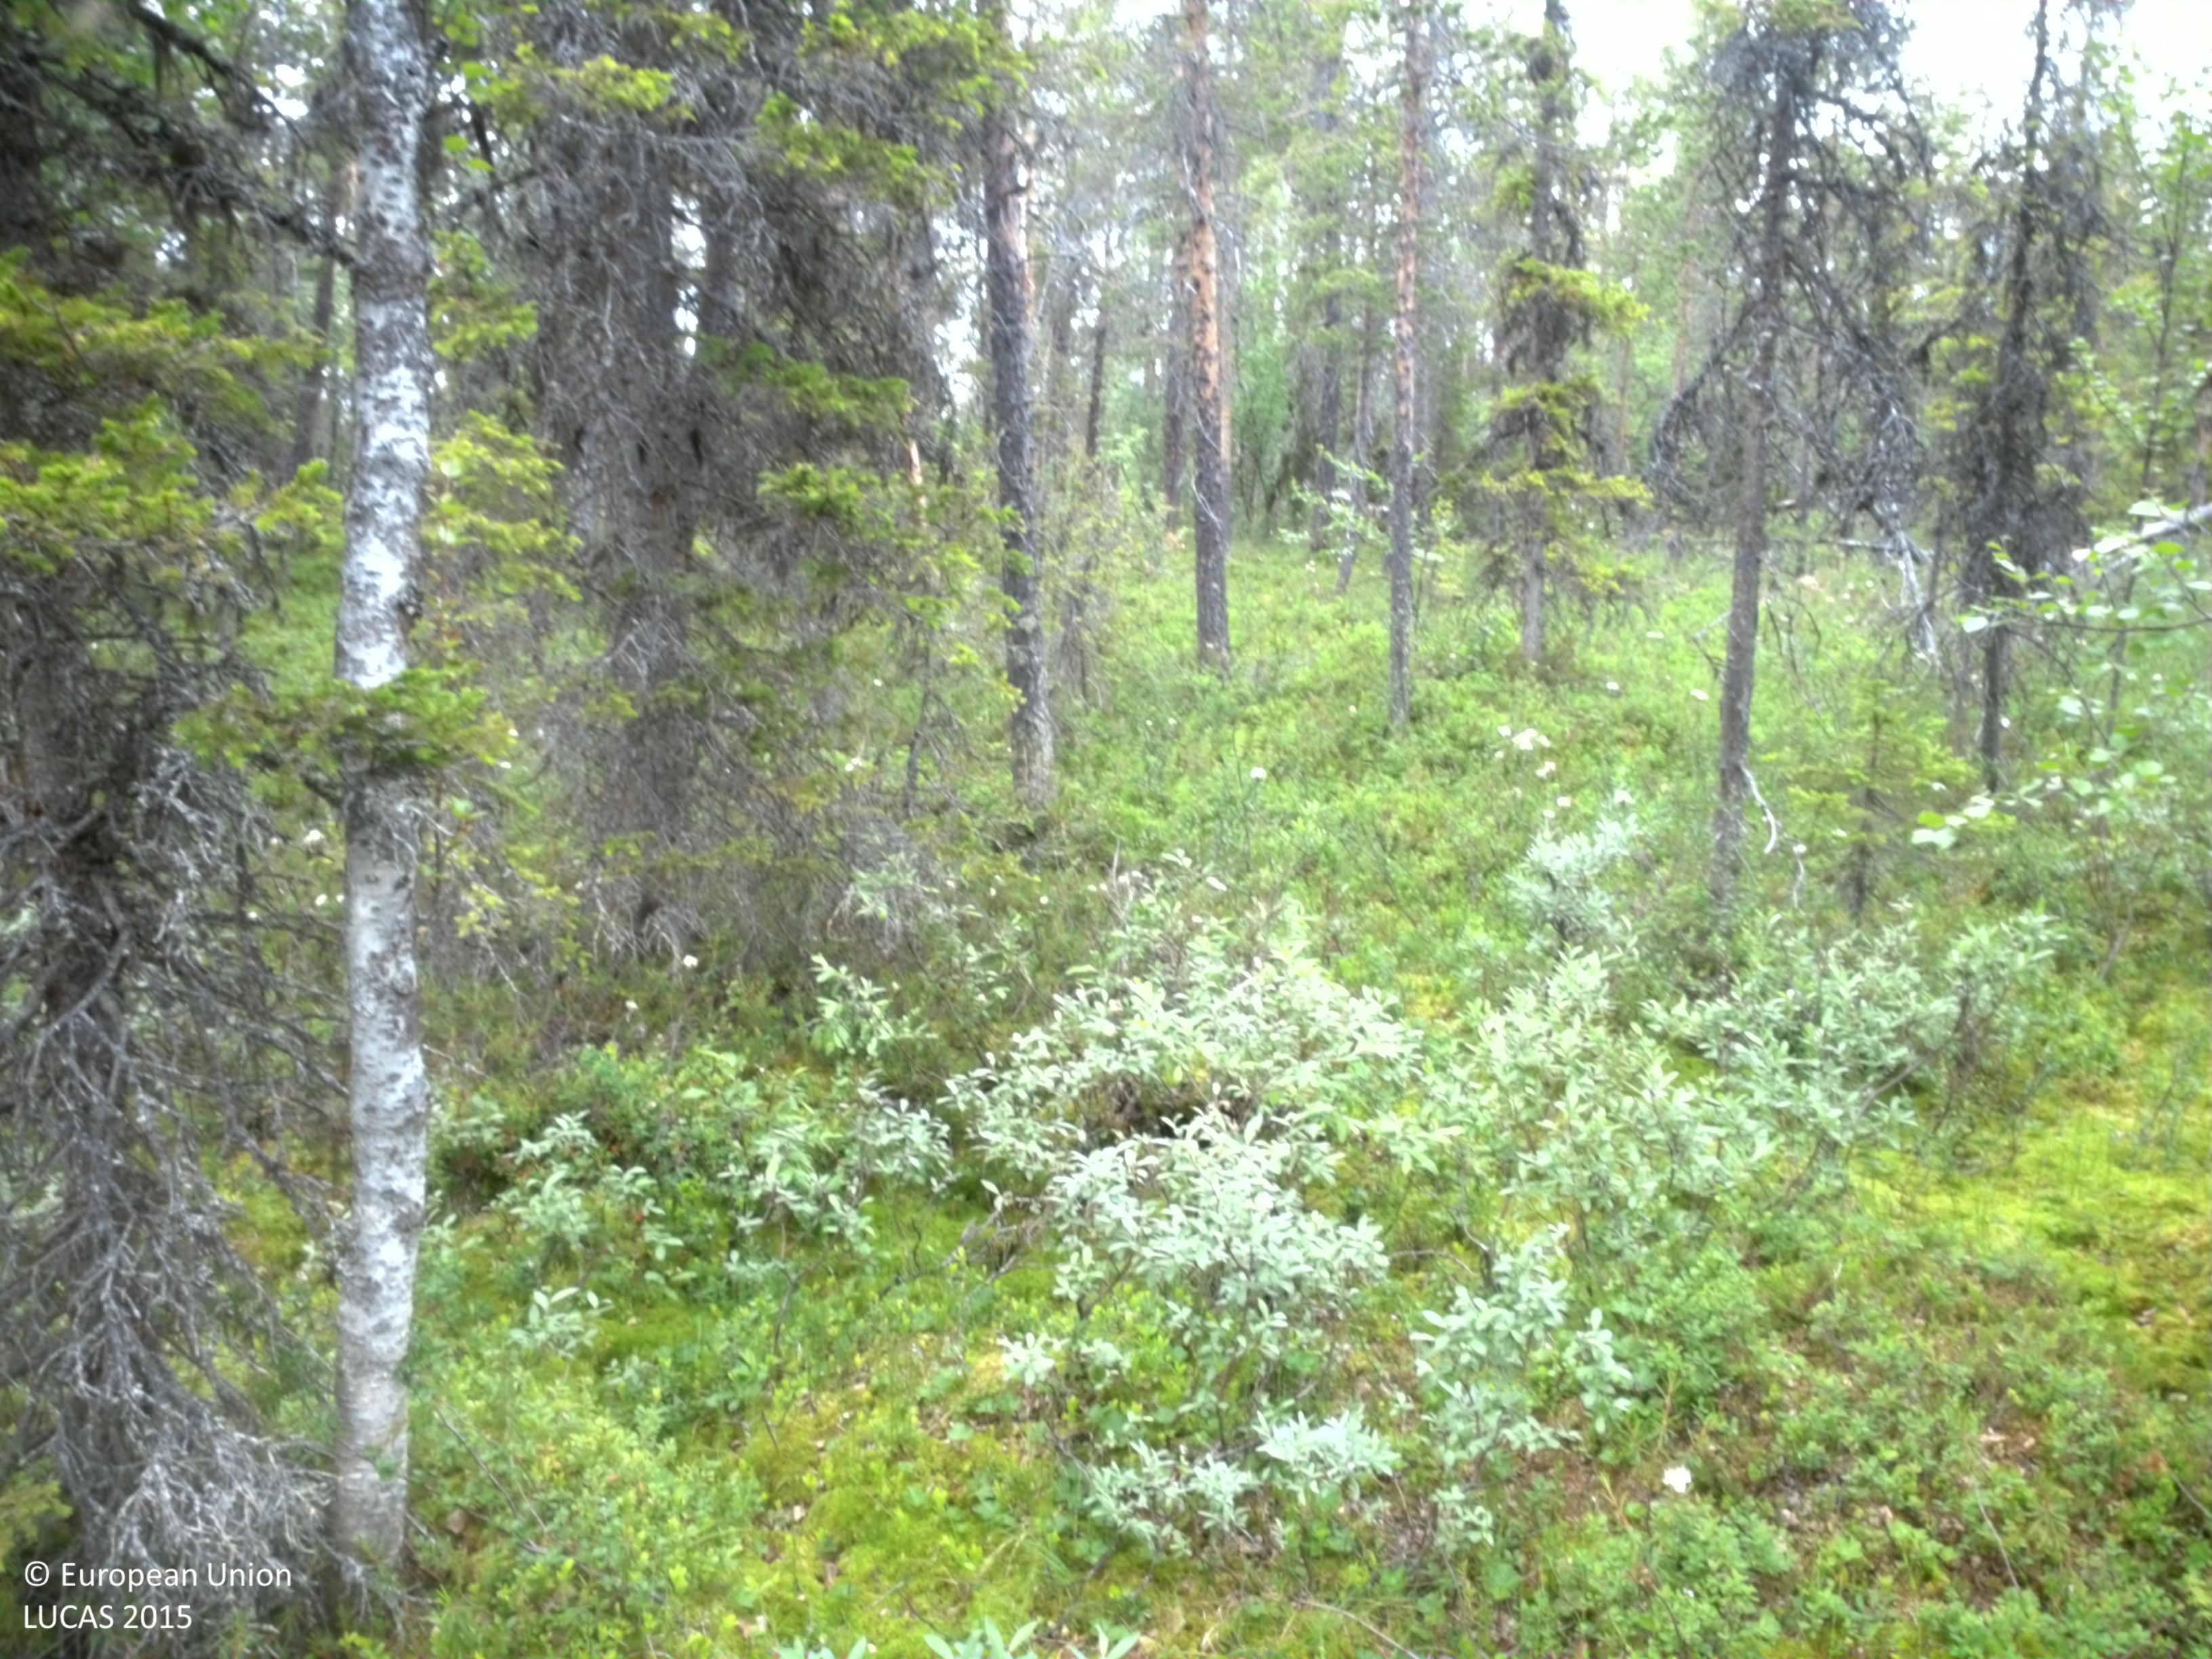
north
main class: Woodland
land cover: Spruce dominated mixed woodland
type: mire and swamp forests
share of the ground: 50 - 75 %
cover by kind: shrubs 40 %, coniferous forest trees 35 %, broadleaved forest trees 20 %, lichens and mosses 5 %
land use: Forestry
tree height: > 5 m
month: July
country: SE
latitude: 67.2688
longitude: 19.1506
